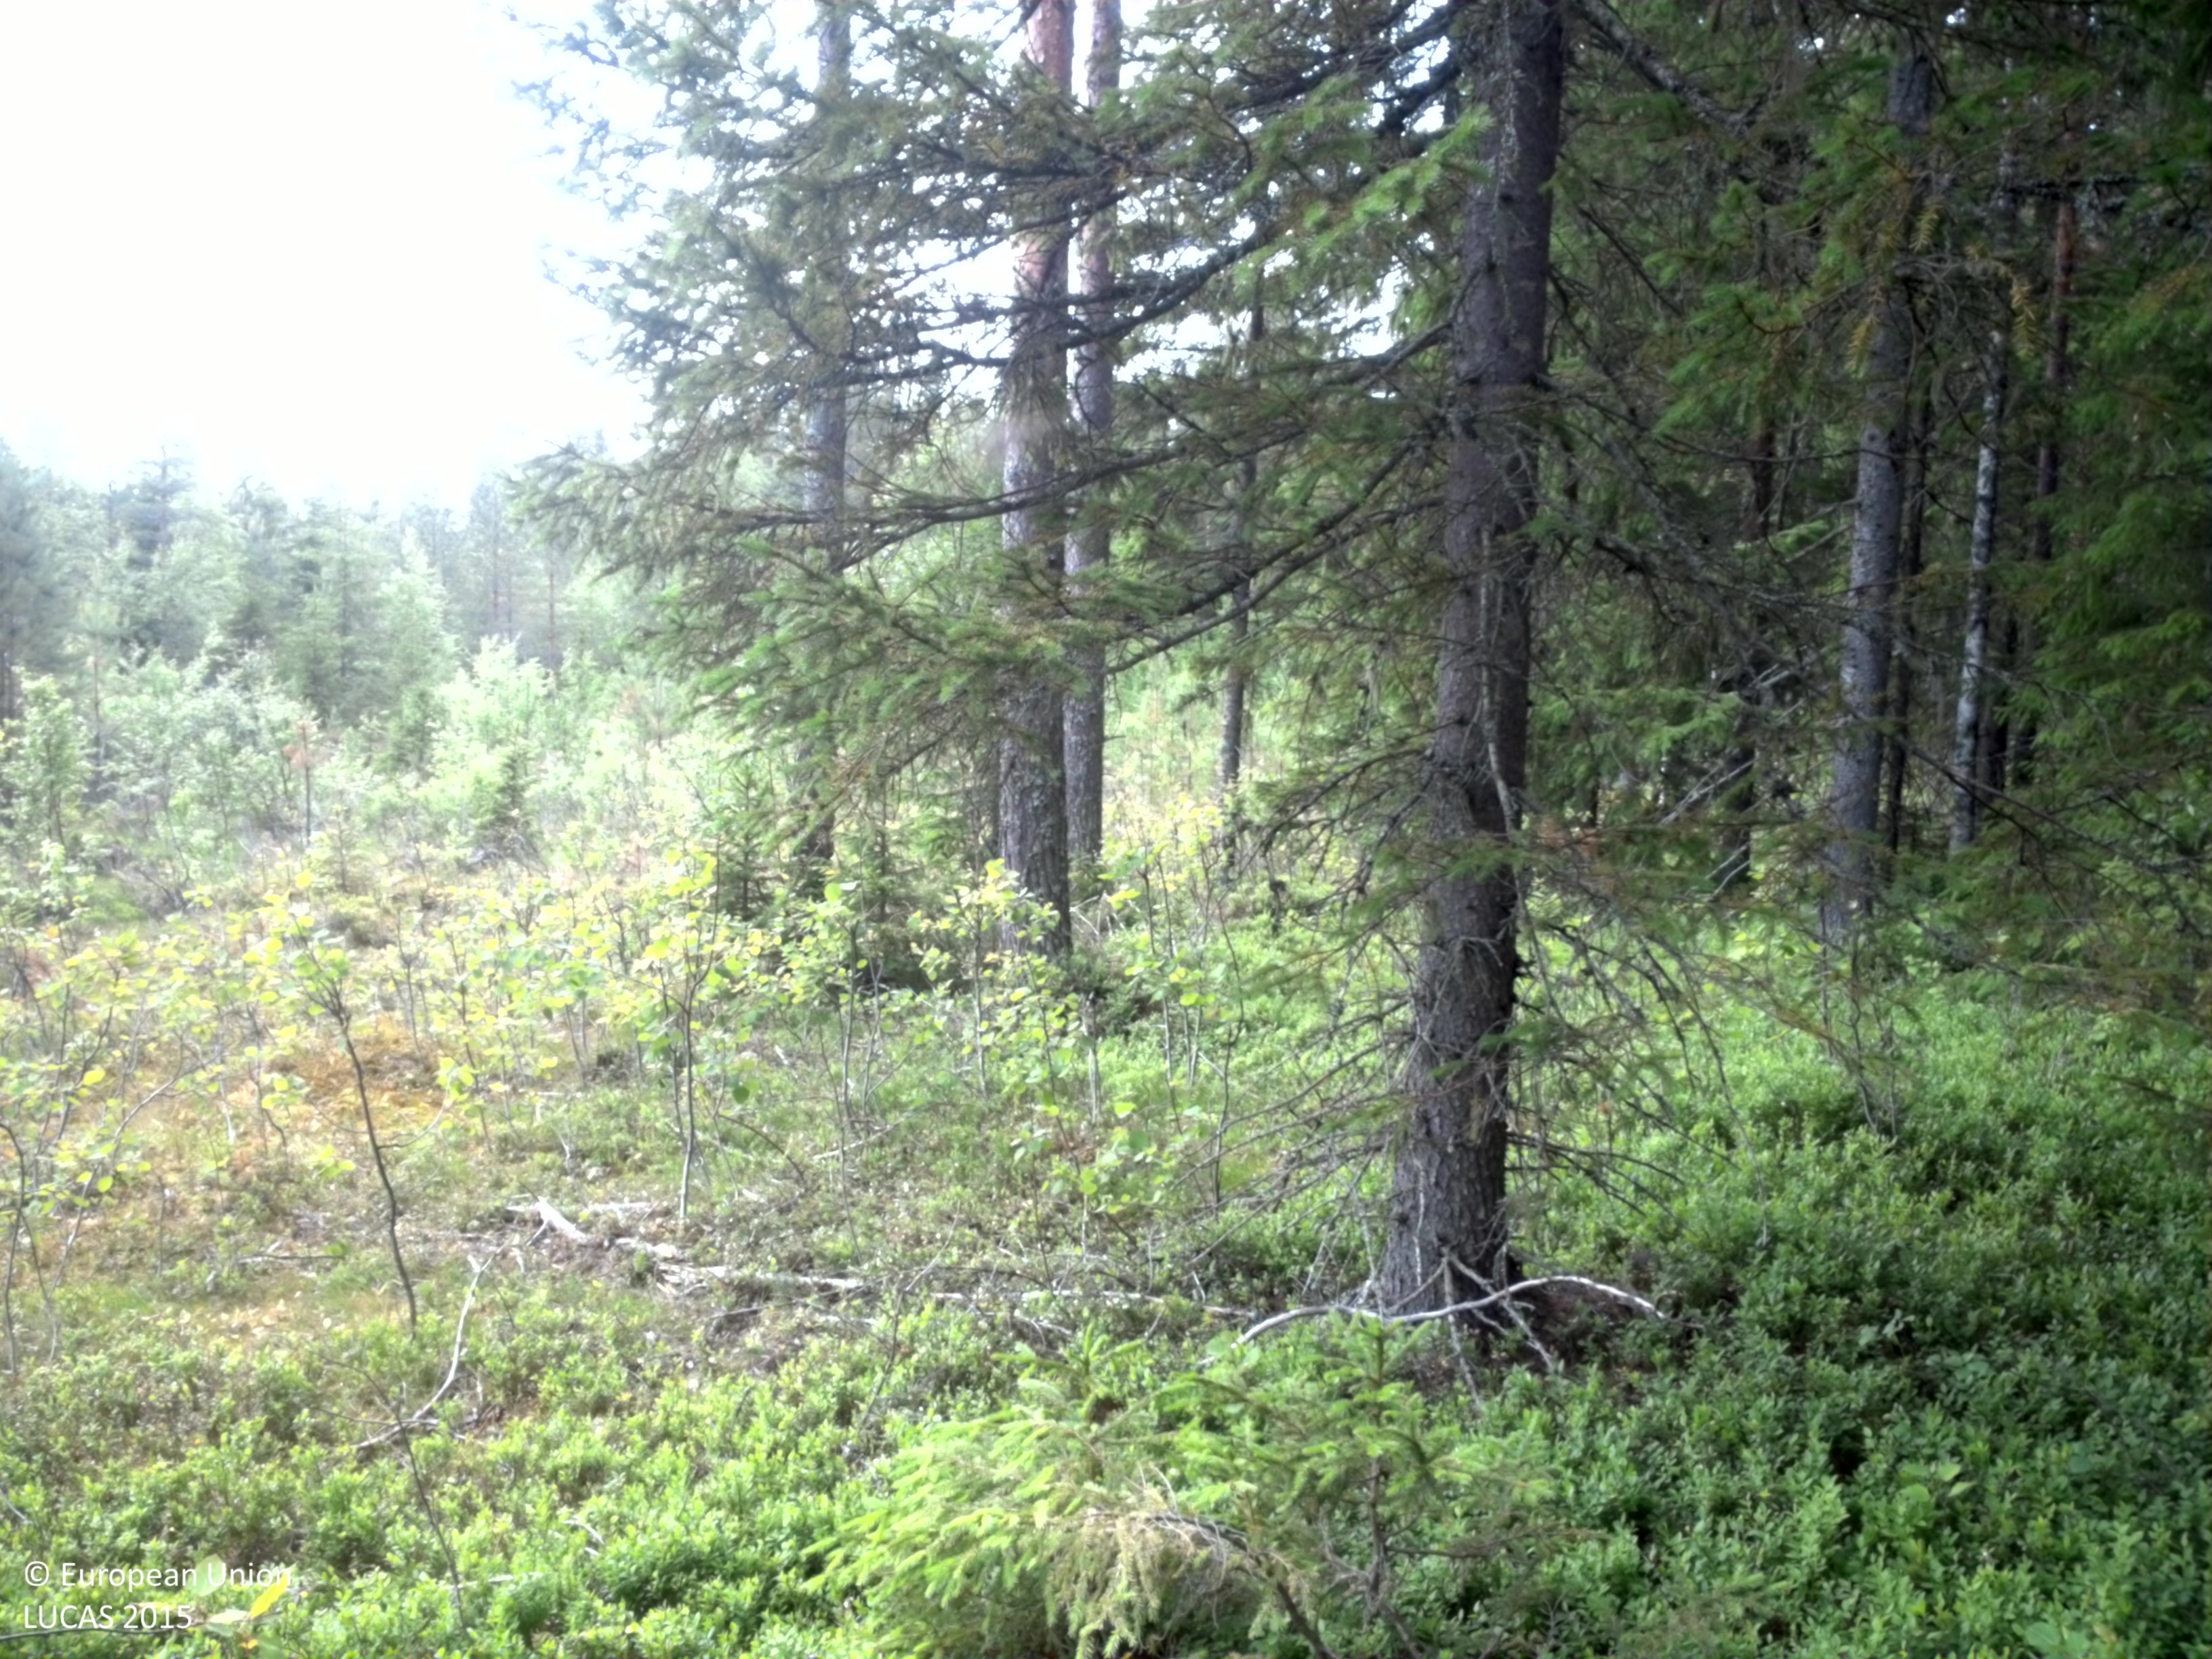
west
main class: Woodland
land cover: Other mixed woodland
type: boreal forest
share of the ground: > 75 %
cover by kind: coniferous forest trees 60 %, broadleaved forest trees 20 %, shrubs 20 %
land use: Forestry
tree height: > 5 m
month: July
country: SE
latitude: 64.4072
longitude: 20.8736
